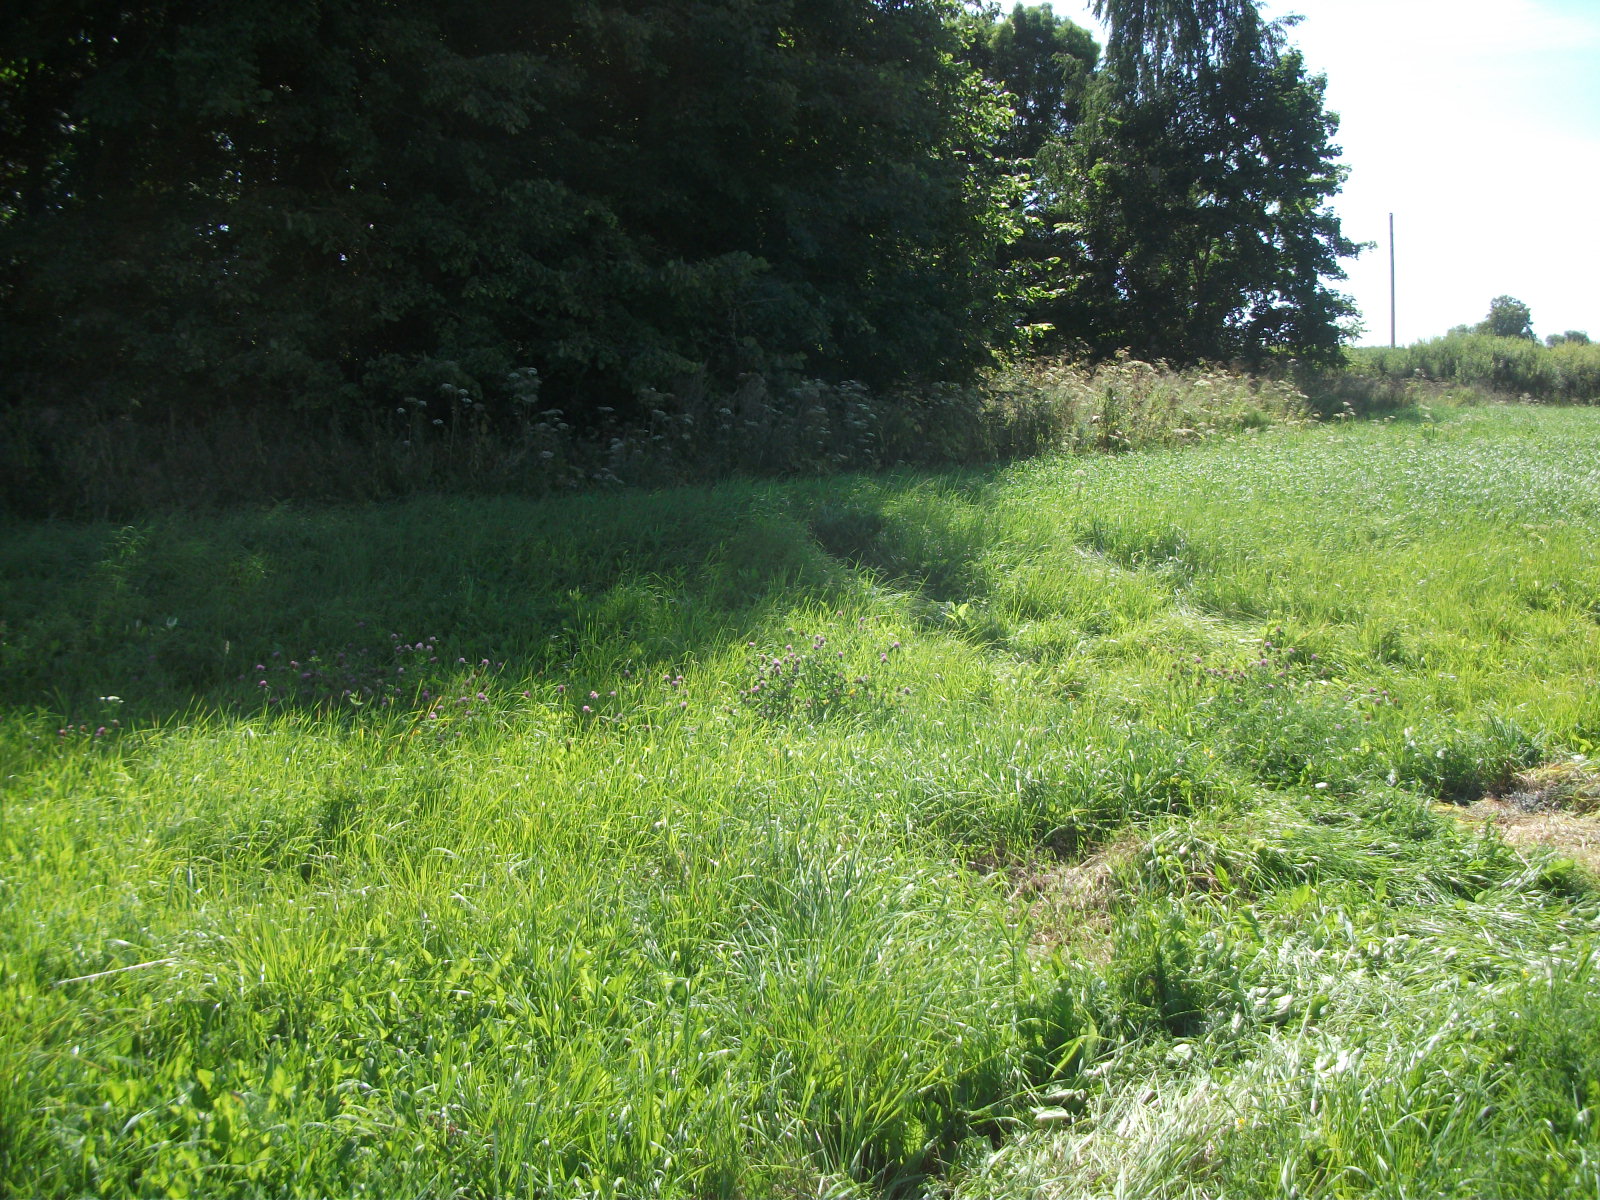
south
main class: Grassland
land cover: Grassland without tree/shrub cover
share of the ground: > 75 %
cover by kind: herbaceous plants 100 %
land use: Agriculture (excluding fallow land and kitchen gardens)
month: August
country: LV
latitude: 56.2270
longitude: 26.3883
